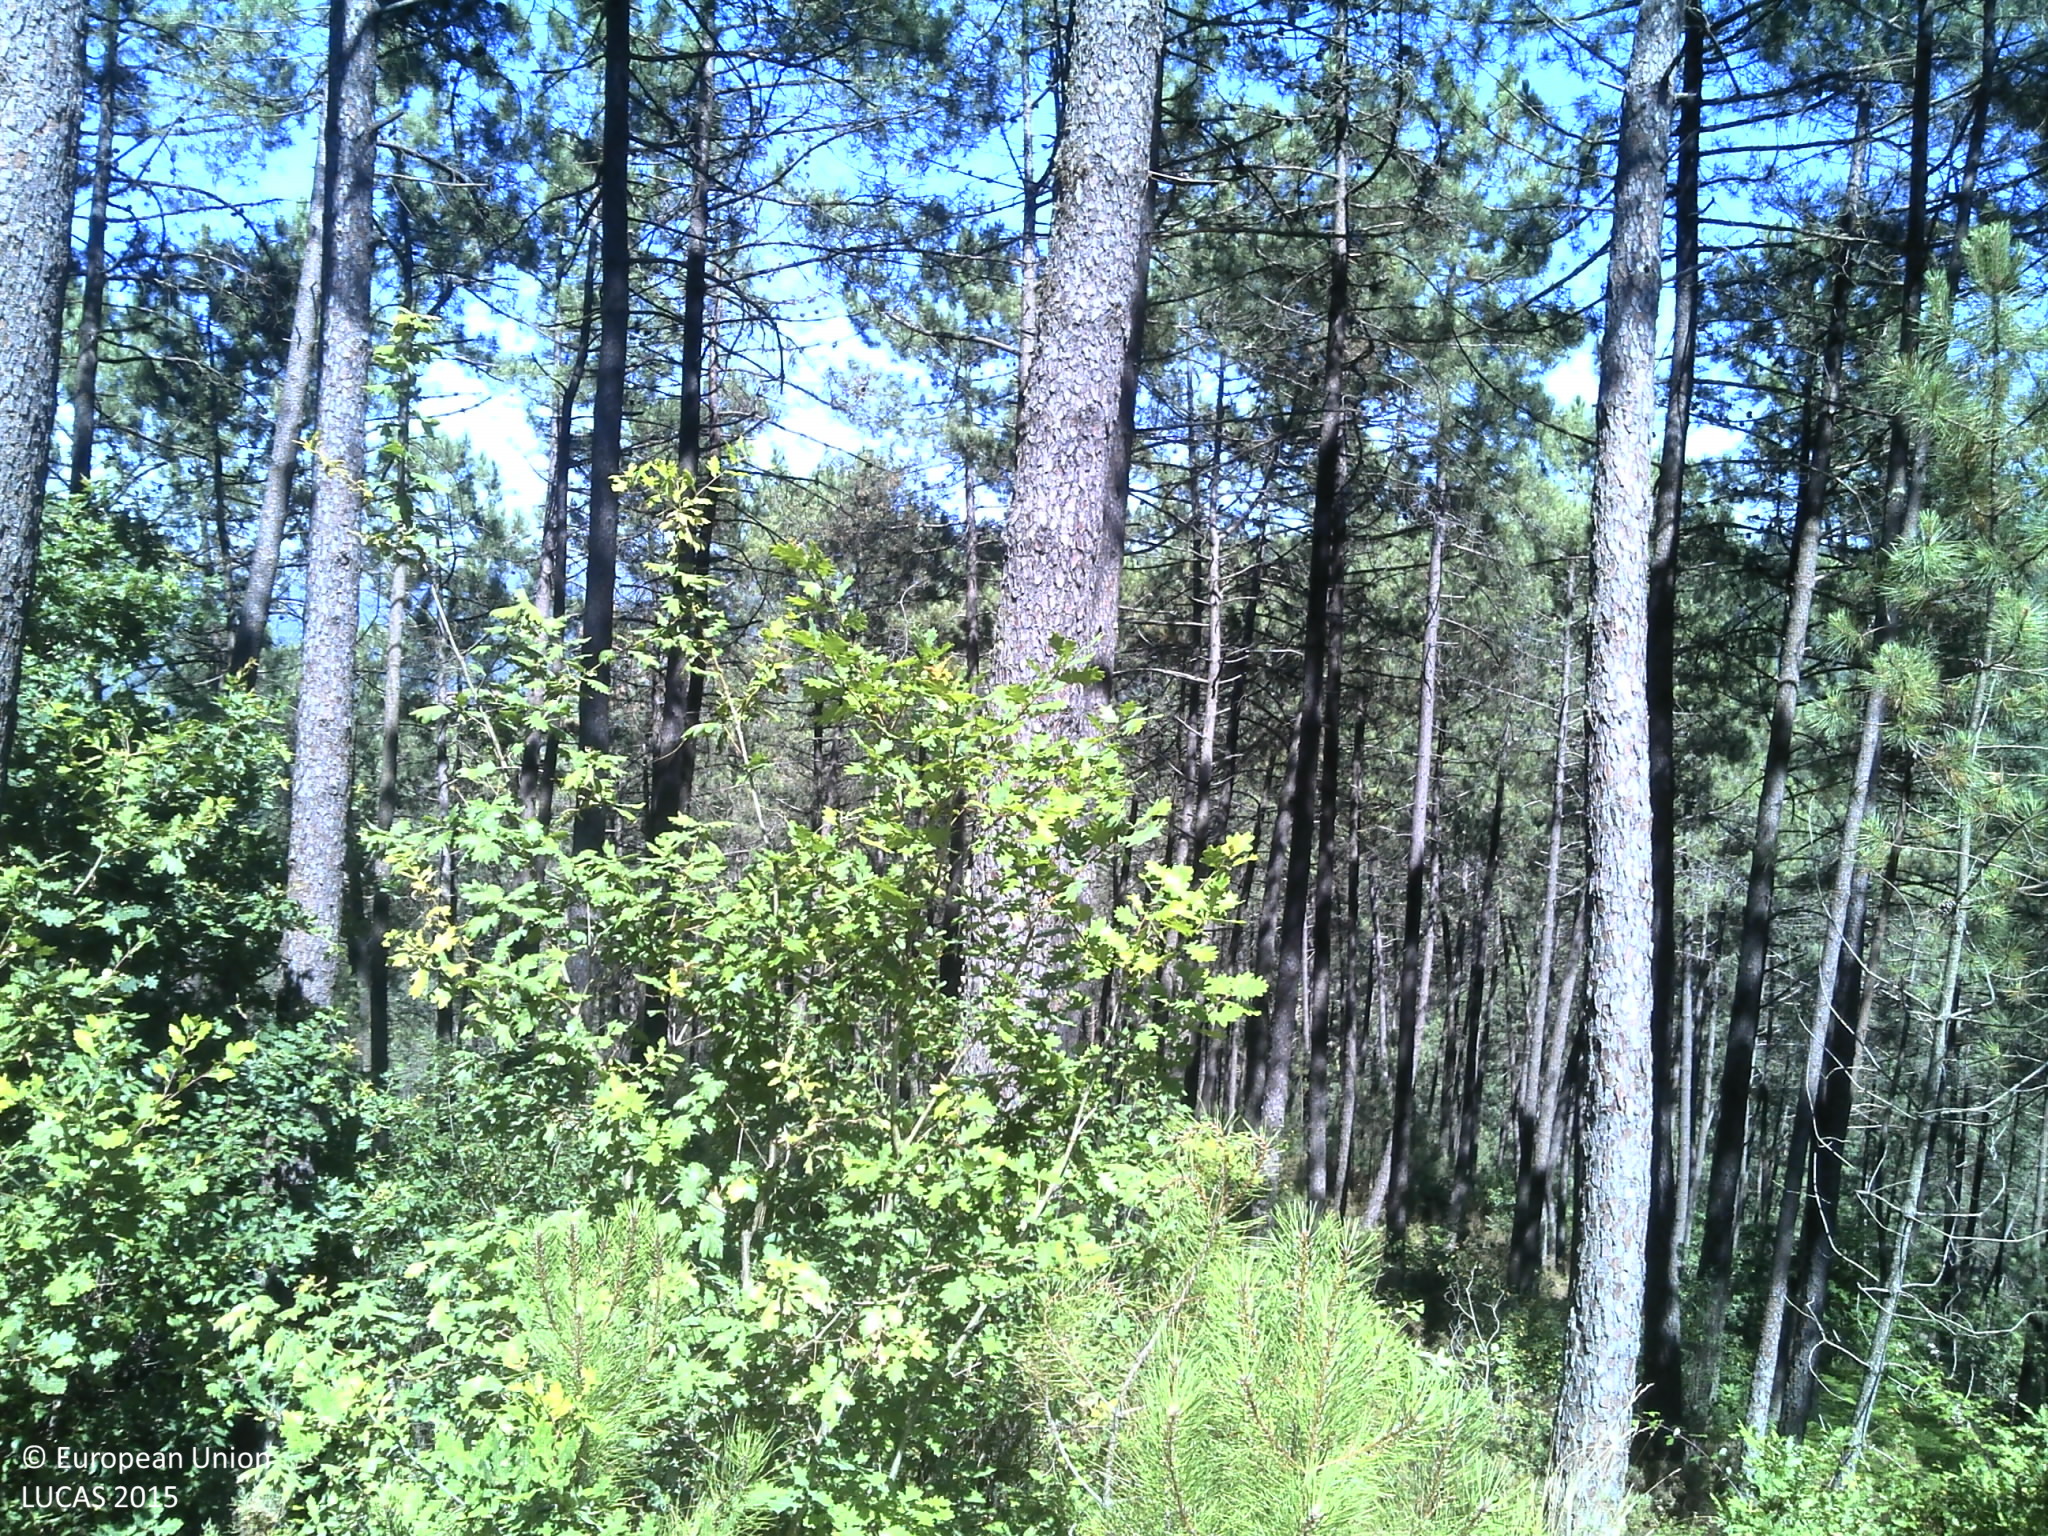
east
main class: Woodland
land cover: Pine dominated coniferous woodland
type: coniferous forest of the mediterranean region
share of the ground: 50 - 75 %
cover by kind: coniferous forest trees 60 %, shrubs 25 %, unconsolidated bare surface 15 %
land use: Forestry
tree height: > 5 m
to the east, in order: Pine dominated coniferous woodland
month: June
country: PT
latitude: 40.6269
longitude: -8.2565
